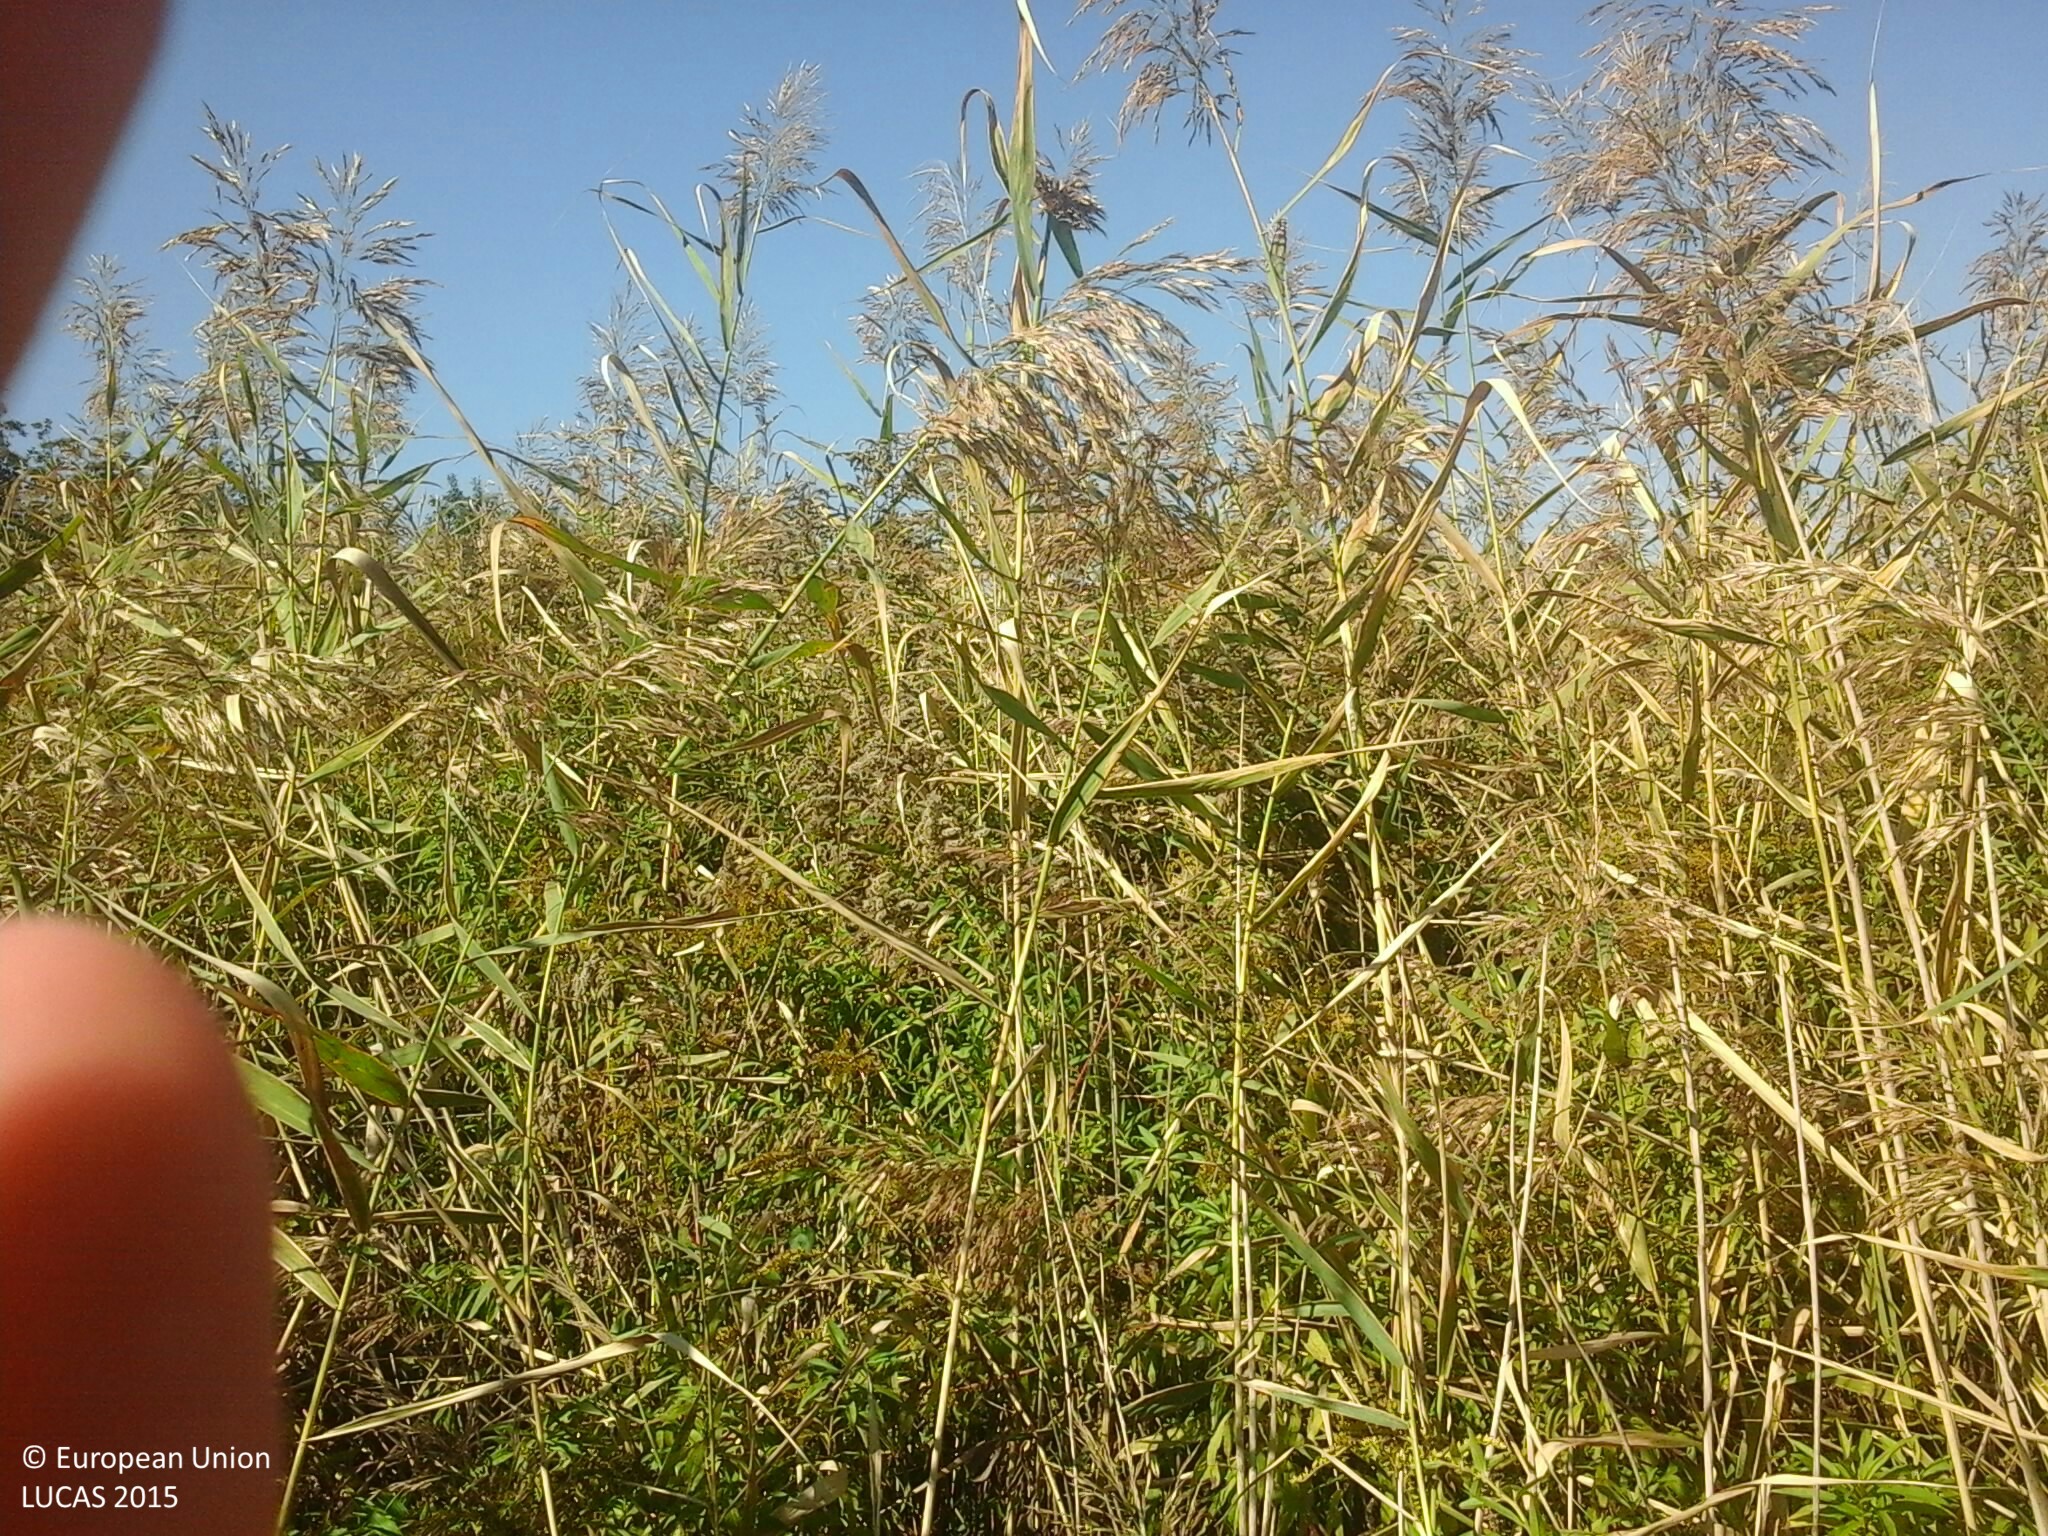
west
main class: Grassland
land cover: Spontaneously vegetated surfaces
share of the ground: > 75 %
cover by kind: herbaceous plants 100 %
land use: Abandoned areas
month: September
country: HU
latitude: 48.0451
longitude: 19.9407
